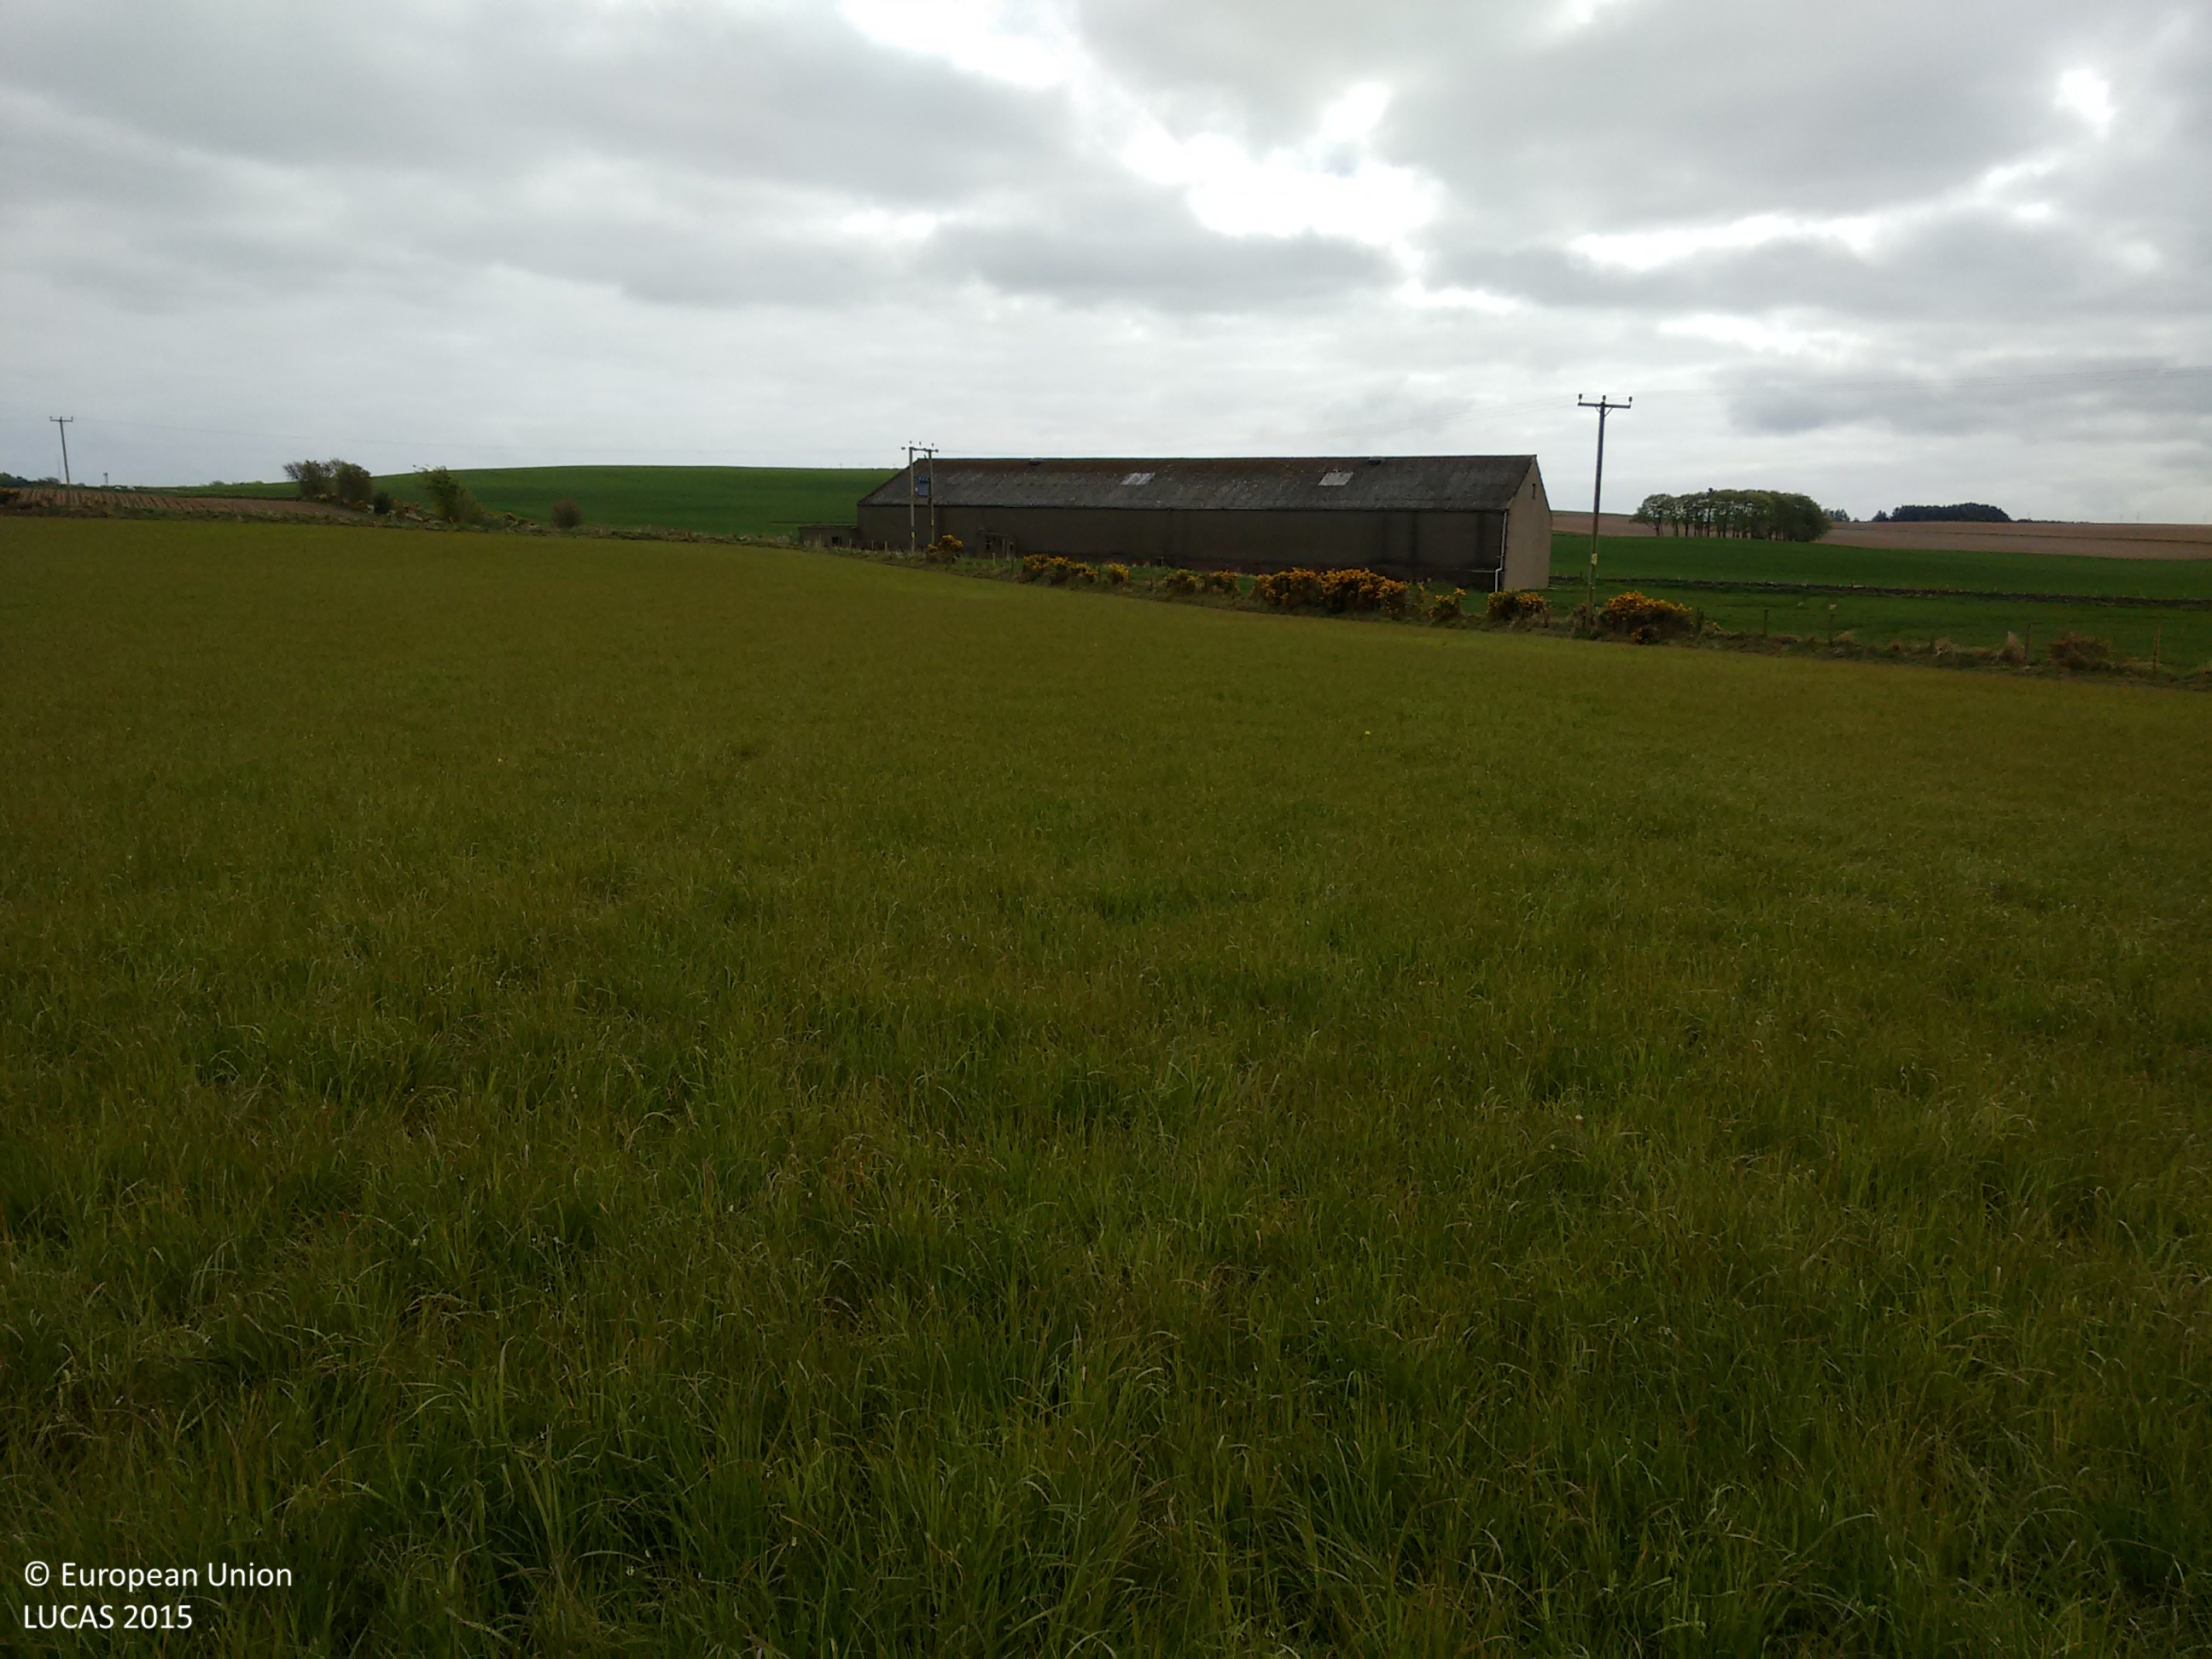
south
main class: Cropland
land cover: Temporary grasslands
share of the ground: > 75 %
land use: Agriculture (excluding fallow land and kitchen gardens)
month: May
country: GB
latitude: 56.6089
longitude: -2.7194
